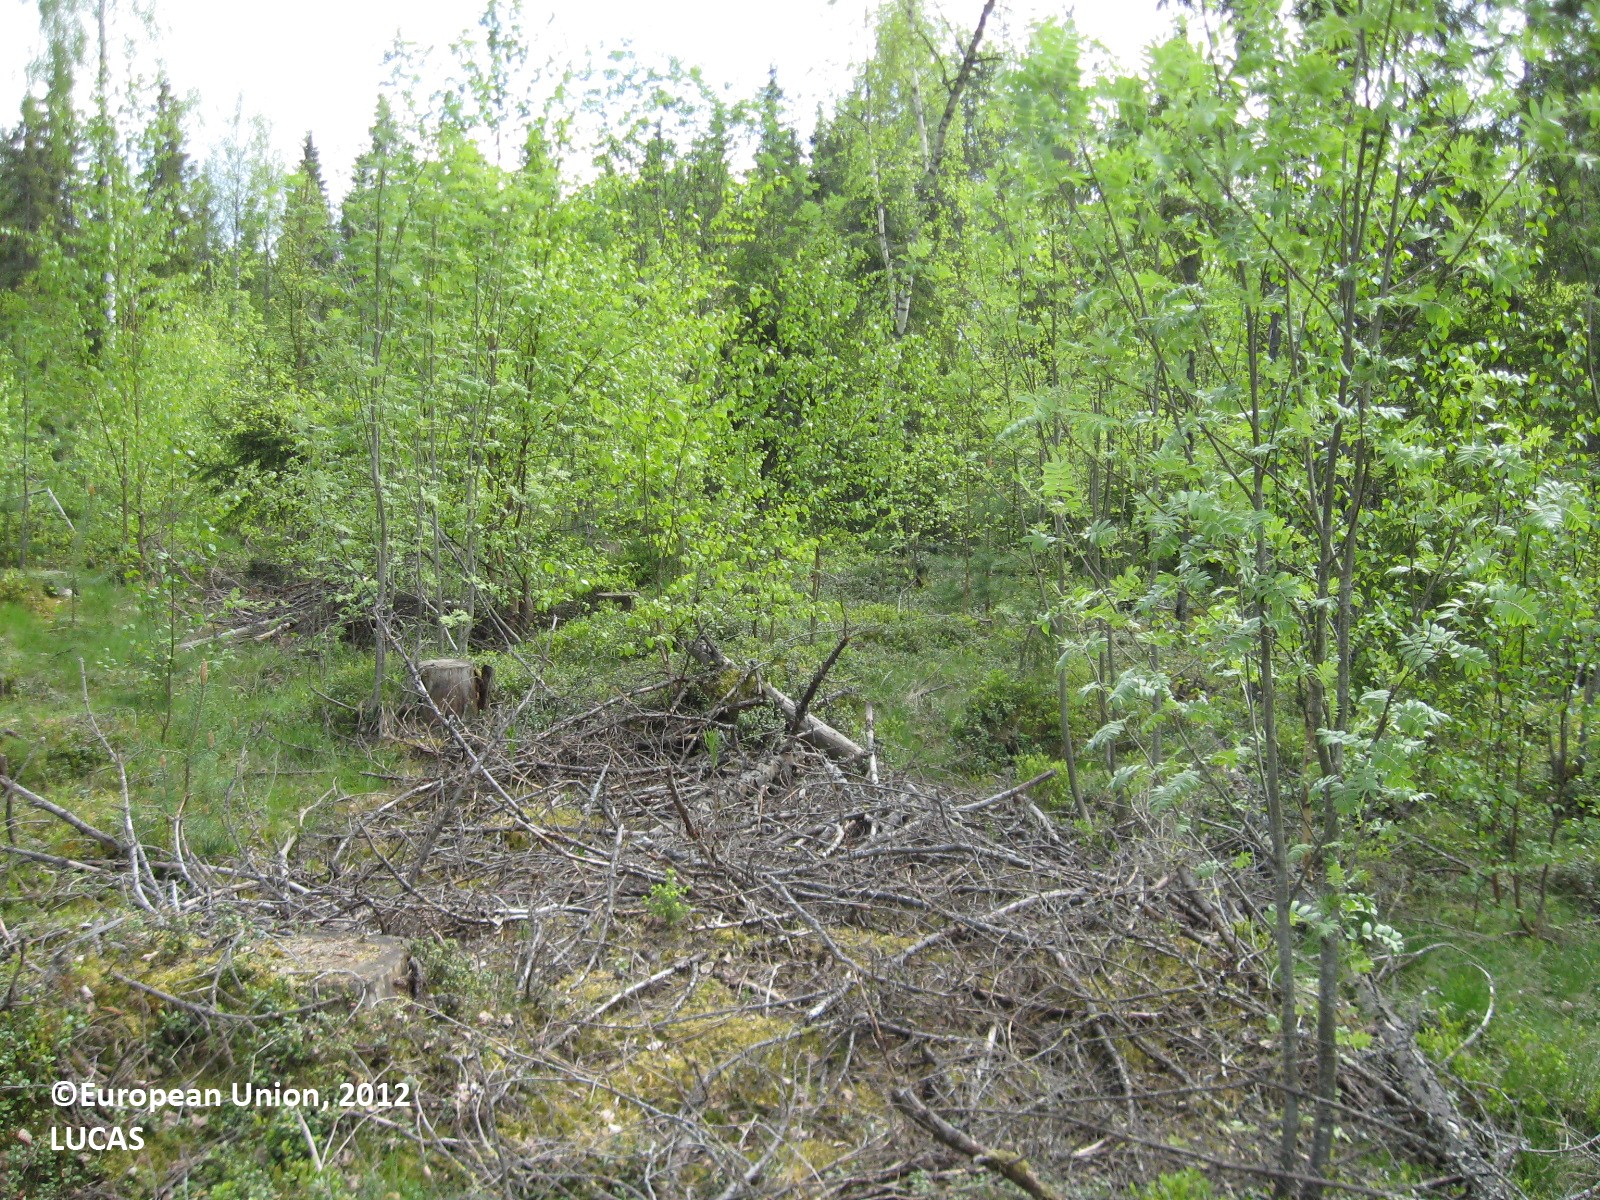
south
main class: Woodland
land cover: Other mixed woodland
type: boreal forest
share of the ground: 25 - 50 %
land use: Forestry
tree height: < 5 m
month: May
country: FI
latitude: 61.8411
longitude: 22.6183
